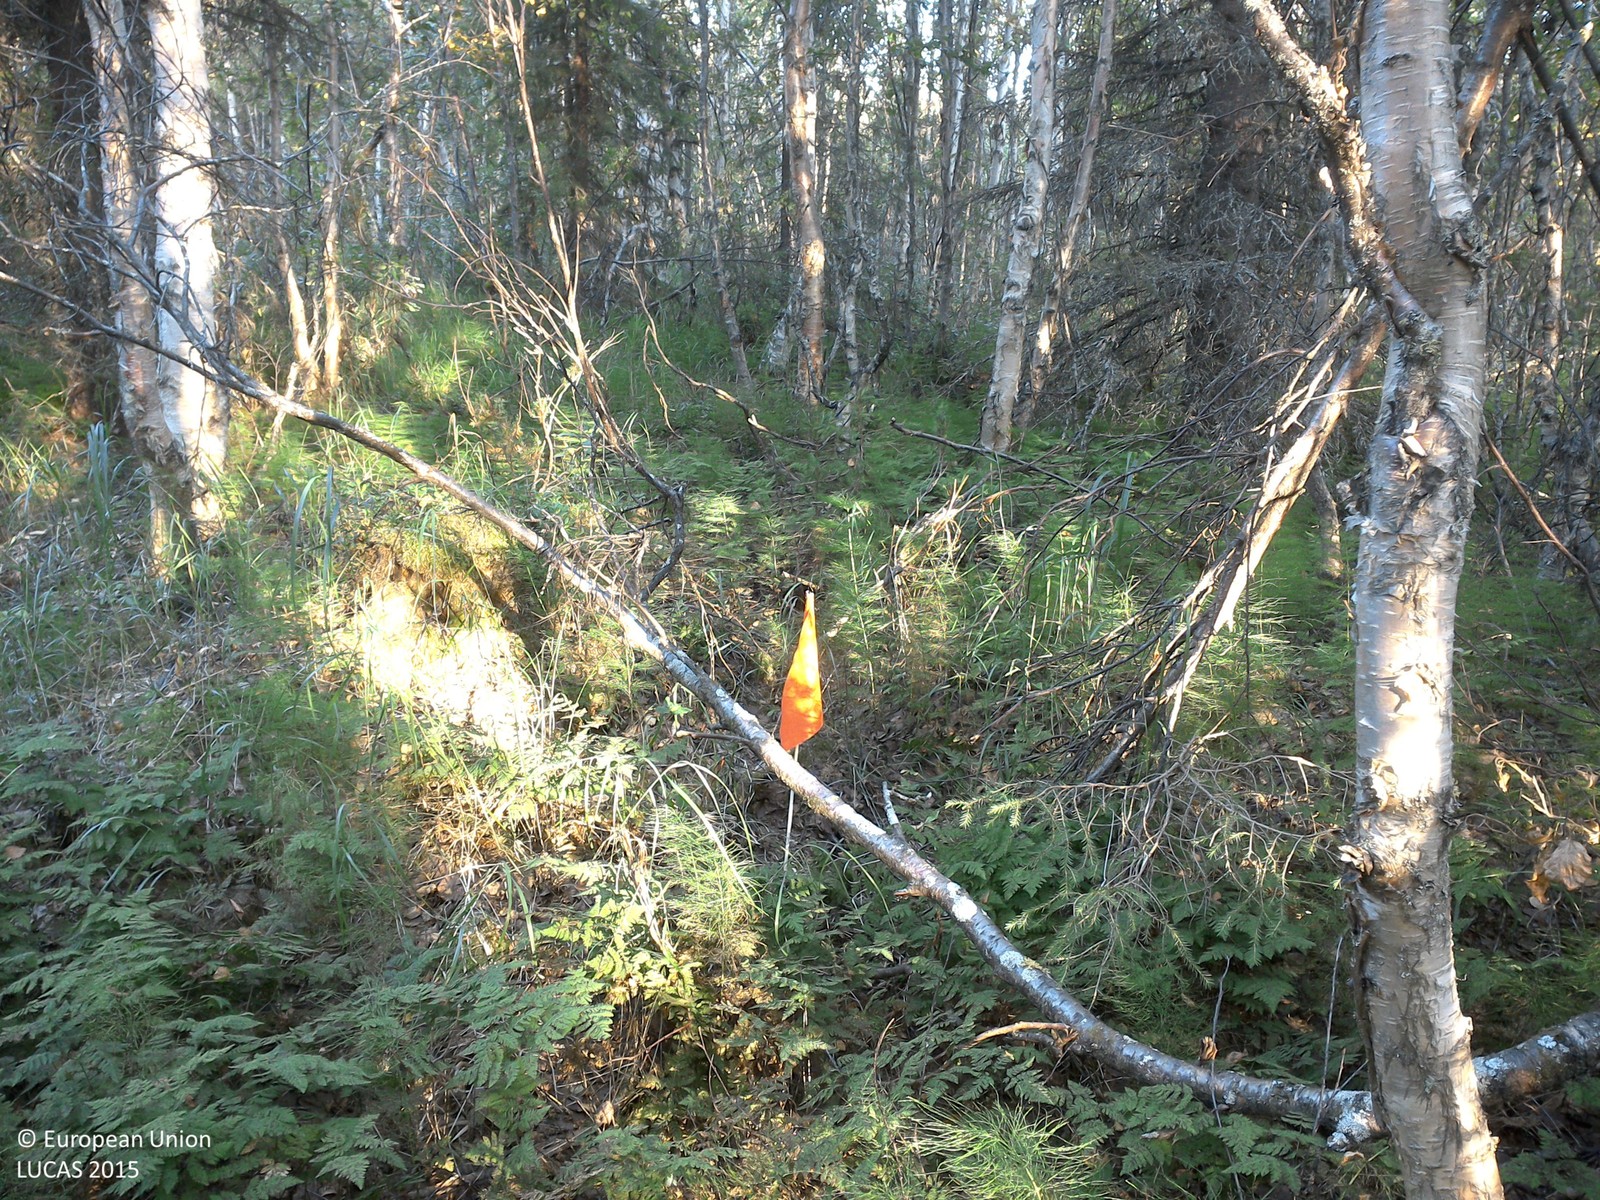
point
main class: Woodland
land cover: Other mixed woodland
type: boreal forest
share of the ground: 25 - 50 %
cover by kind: herbaceous plants 45 %, coniferous forest trees 20 %, broadleaved forest trees 20 %, shrubs 5 %
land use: Forestry
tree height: > 5 m
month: August
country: SE
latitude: 67.1286
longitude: 21.7846
